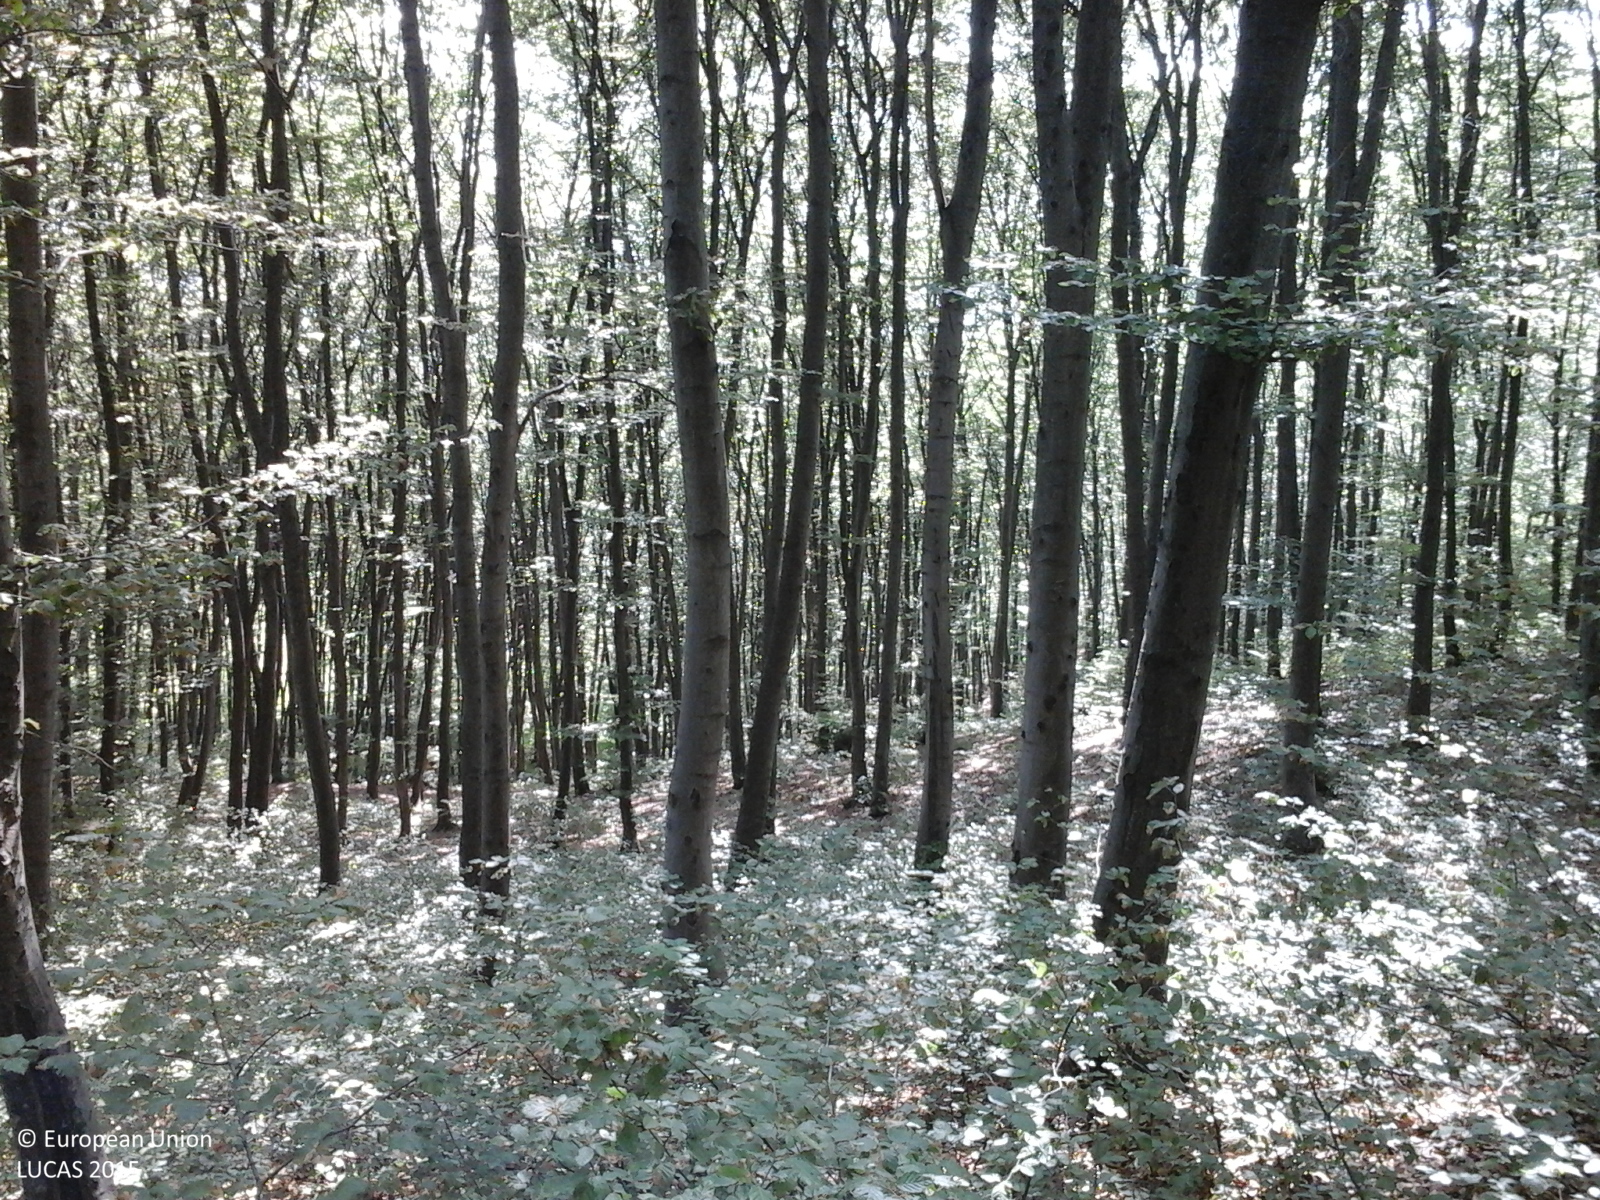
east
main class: Woodland
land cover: Broadleaved woodland
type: beech forest
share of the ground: > 75 %
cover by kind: broadleaved forest trees 100 %
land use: Forestry
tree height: > 5 m
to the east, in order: Broadleaved woodland; Tracks; Broadleaved woodland; Rivers and streams; Broadleaved woodland
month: June
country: RO
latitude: 46.5113
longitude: 26.8388
